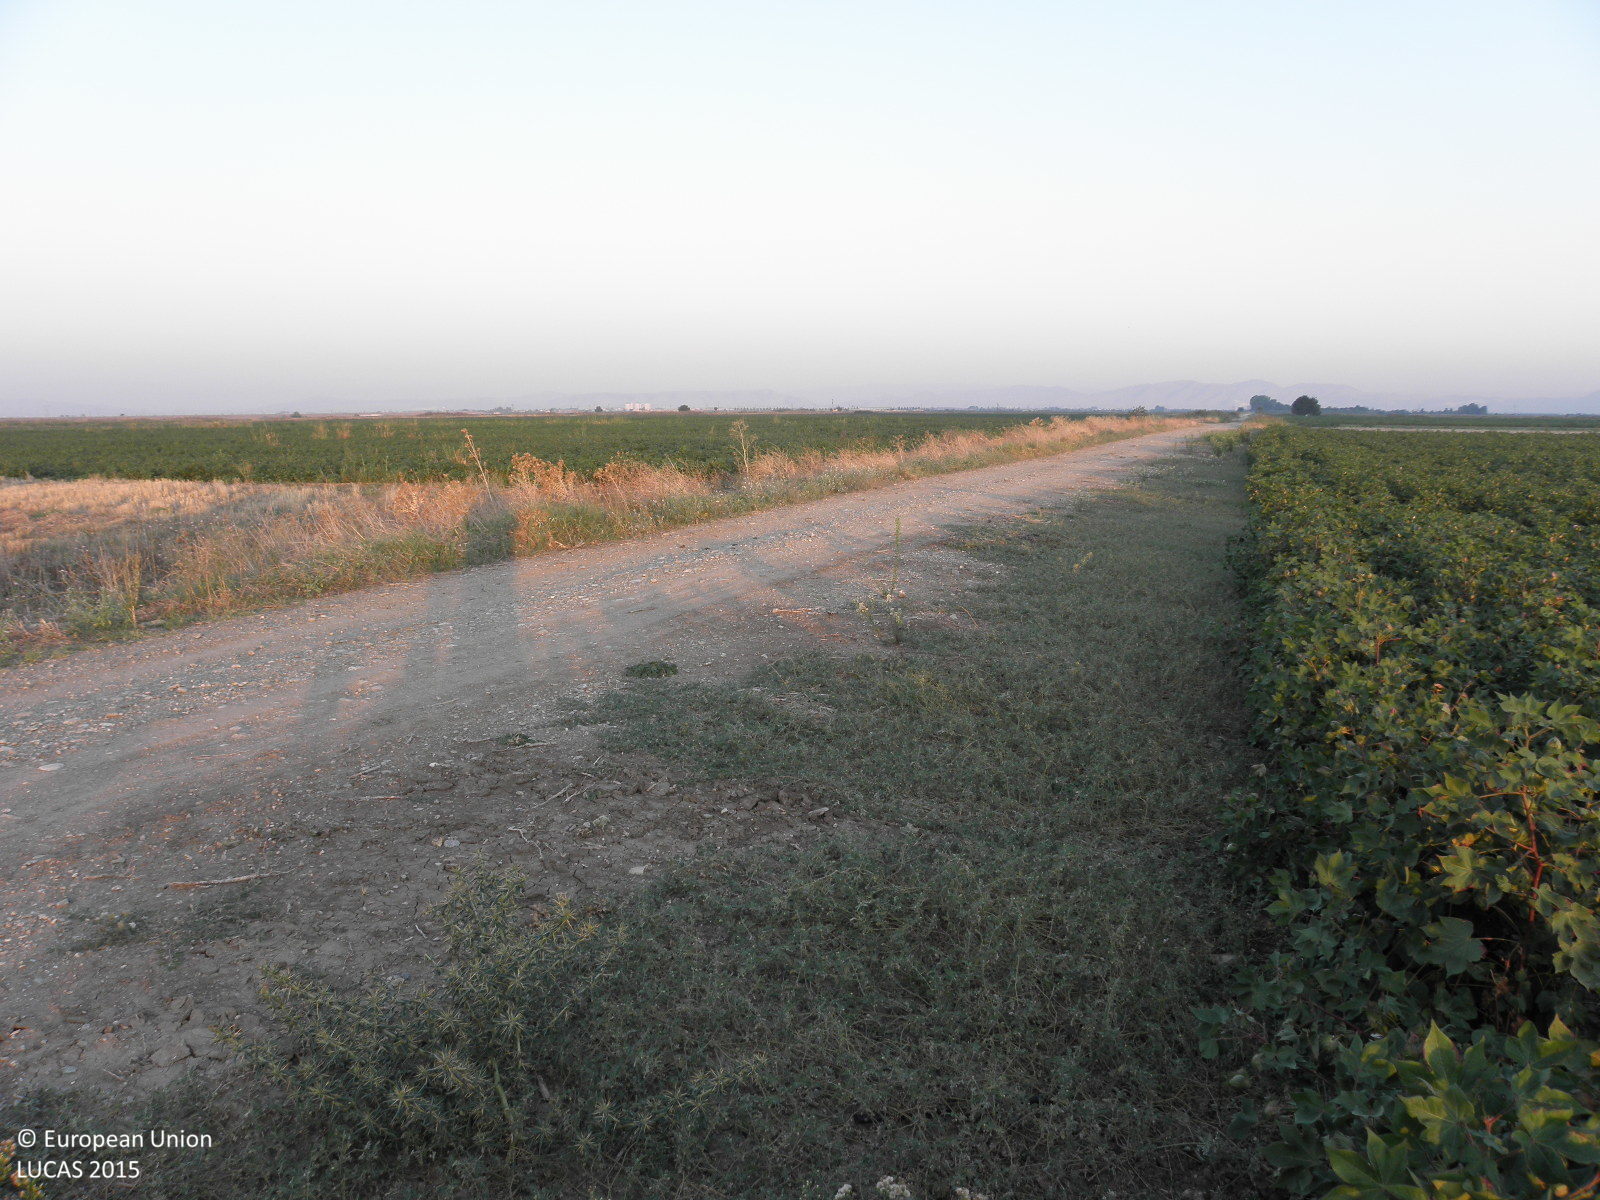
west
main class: Cropland
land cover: Cotton
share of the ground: > 75 %
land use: Agriculture (excluding fallow land and kitchen gardens)
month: September
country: GR
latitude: 39.6807
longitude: 22.5249
